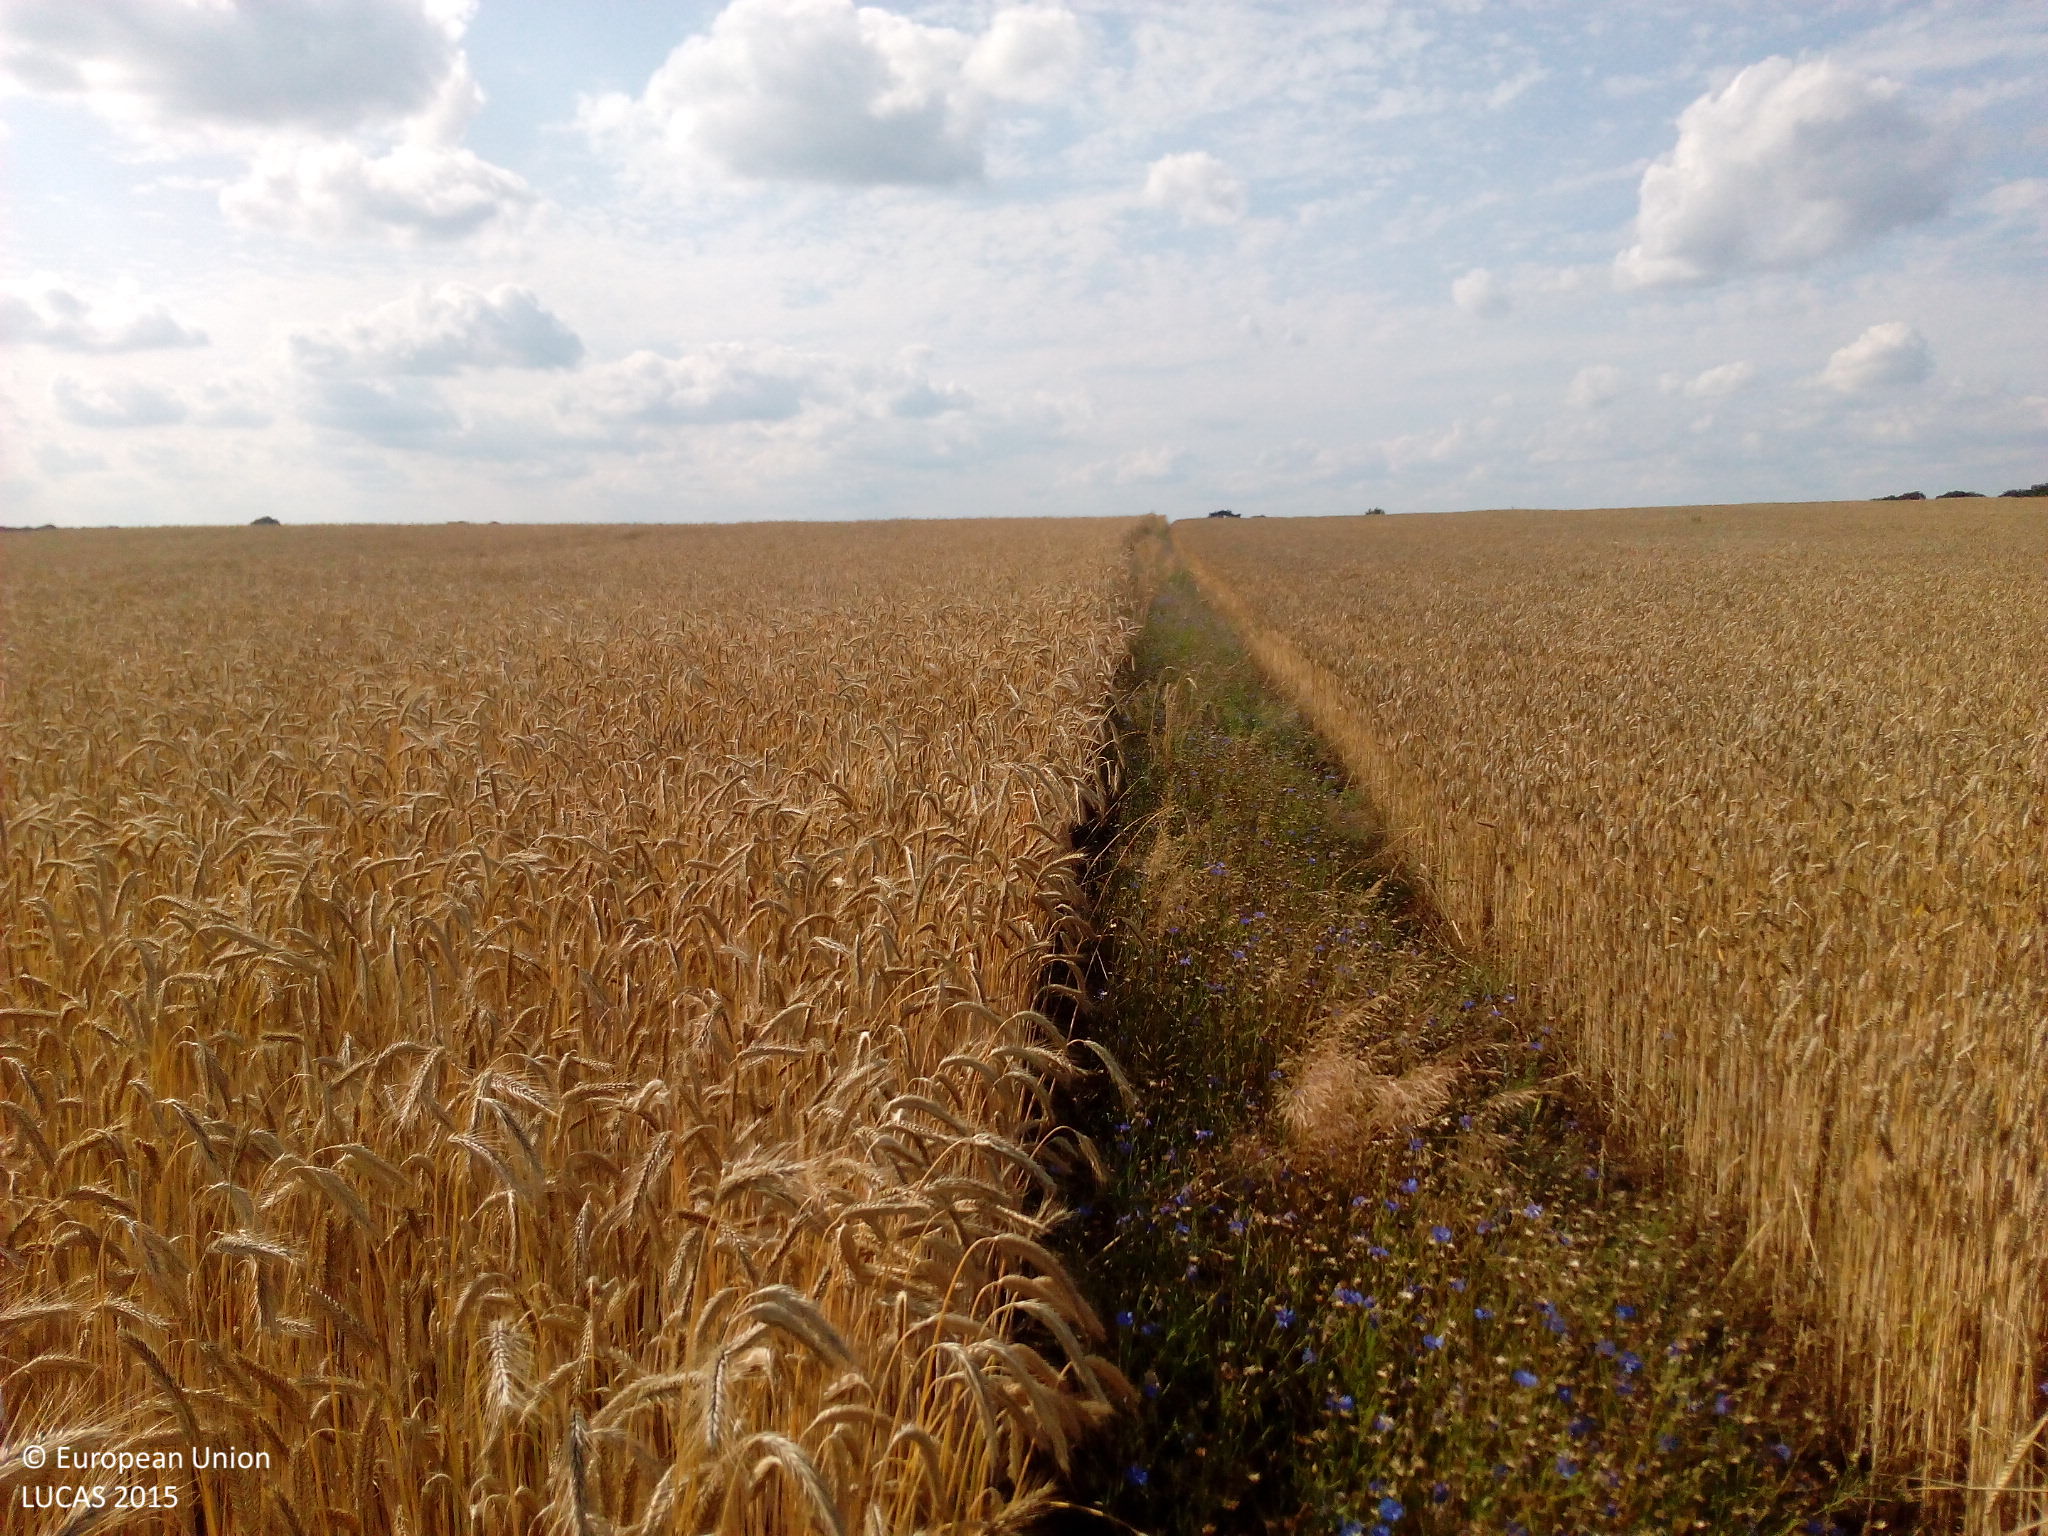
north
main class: Cropland
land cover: Rye
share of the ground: > 75 %
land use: Agriculture (excluding fallow land and kitchen gardens)
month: July
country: DE
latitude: 52.6396
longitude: 12.4674
